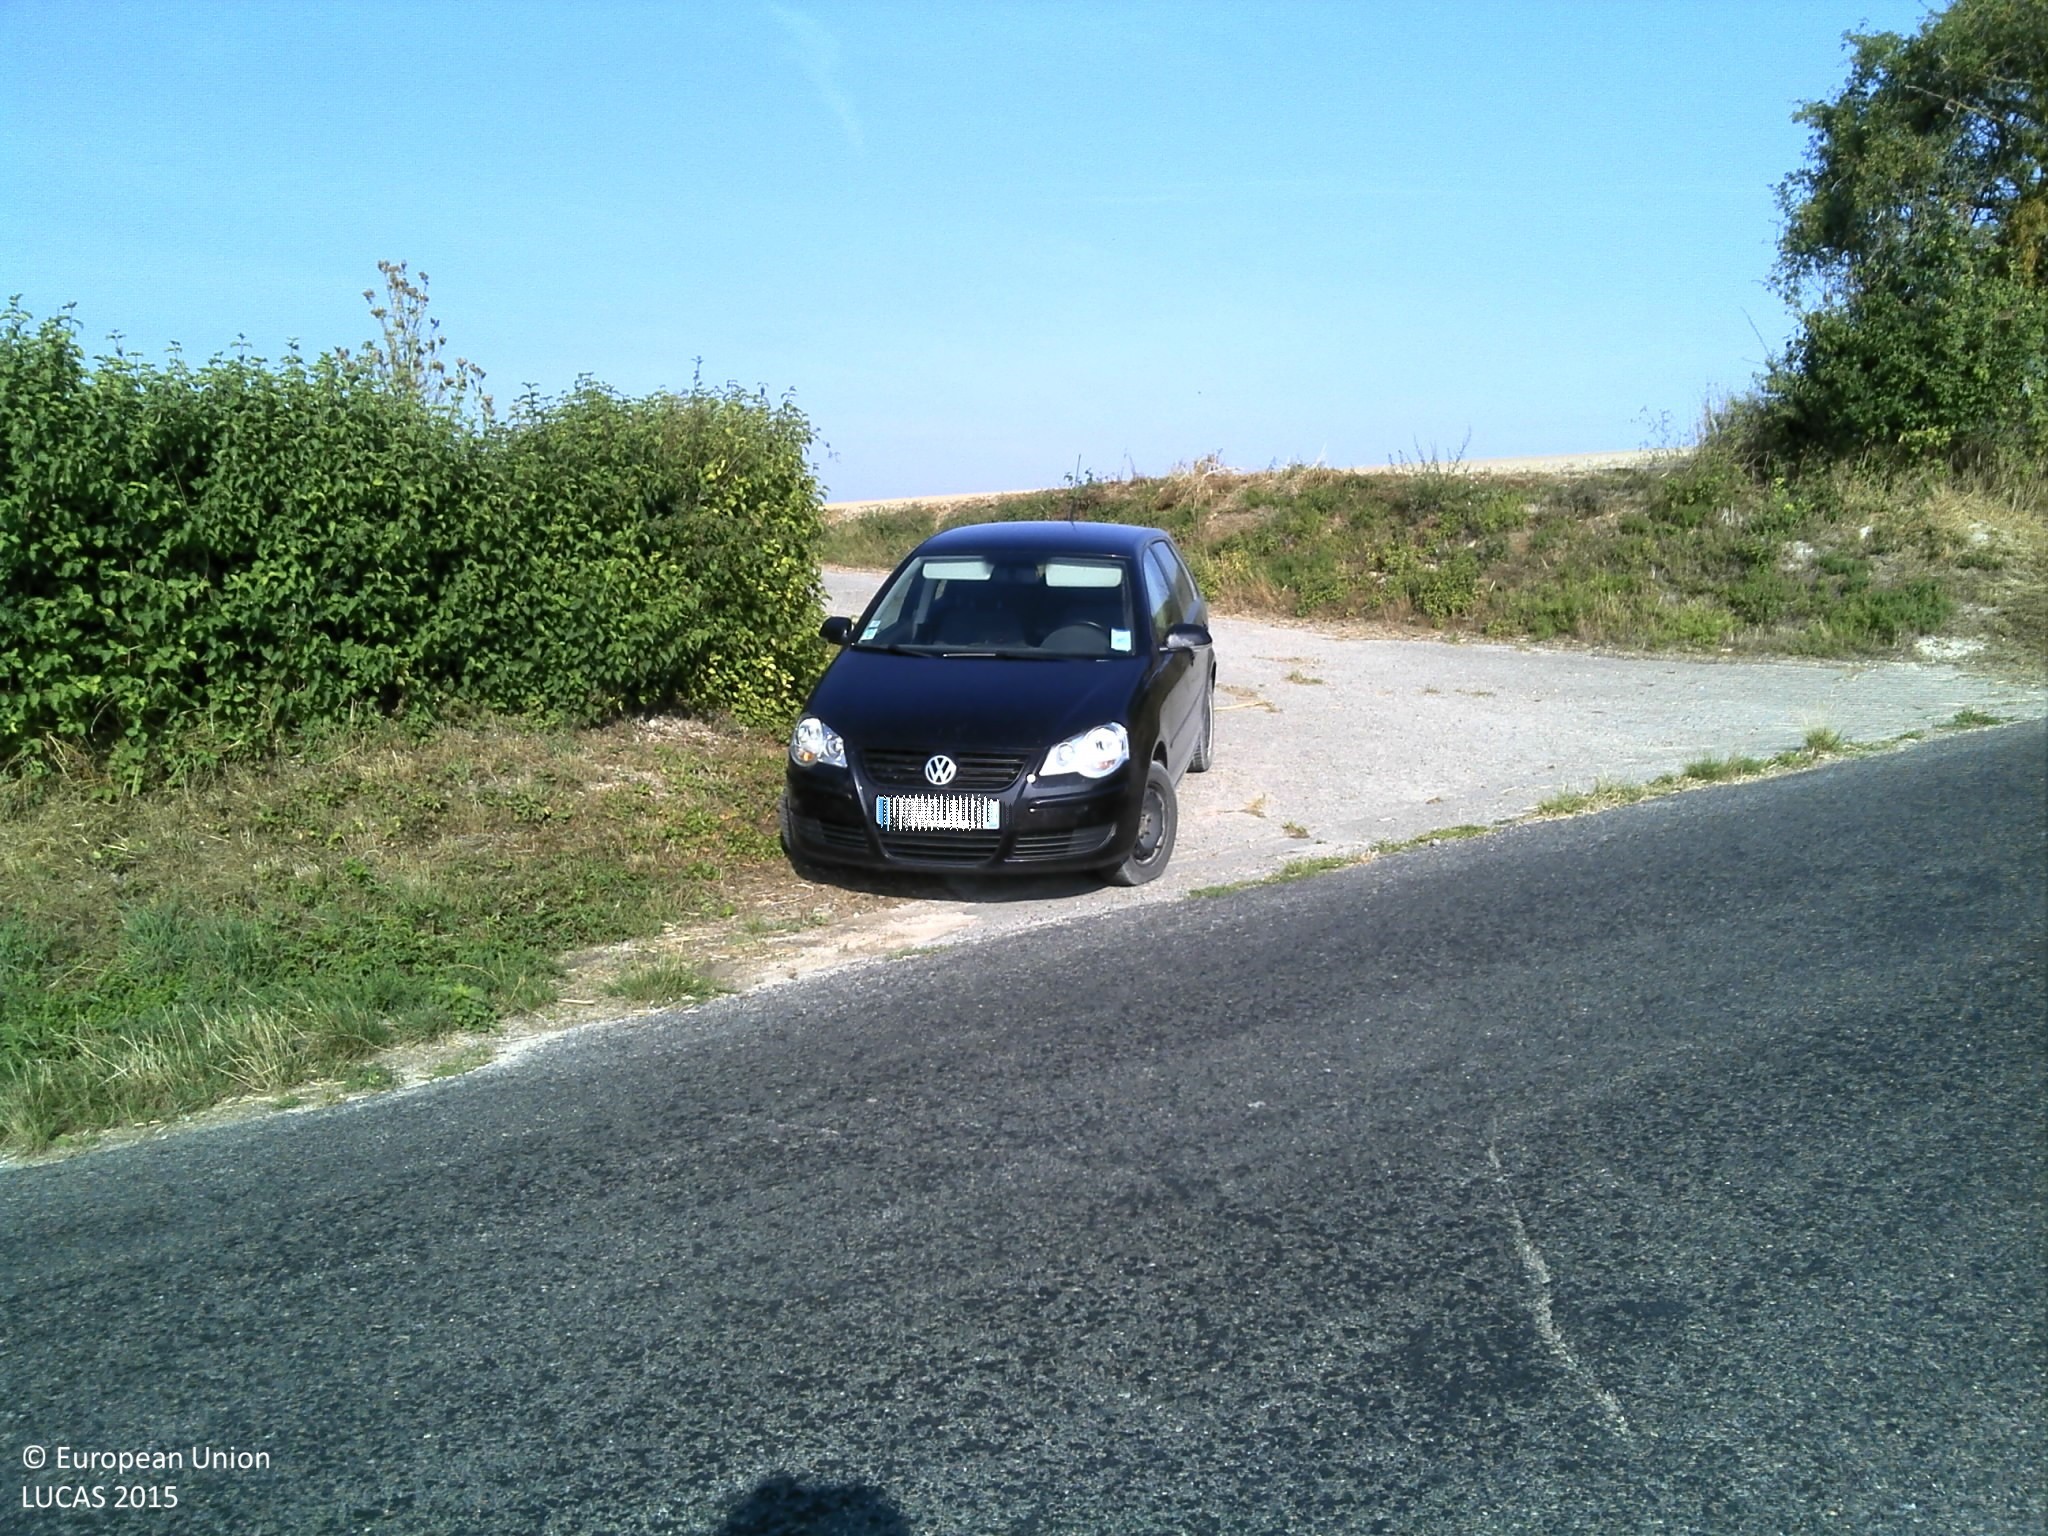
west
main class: Cropland
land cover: Lucerne
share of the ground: > 75 %
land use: Agriculture (excluding fallow land and kitchen gardens)
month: August
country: FR
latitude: 48.9004
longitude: 4.5539
